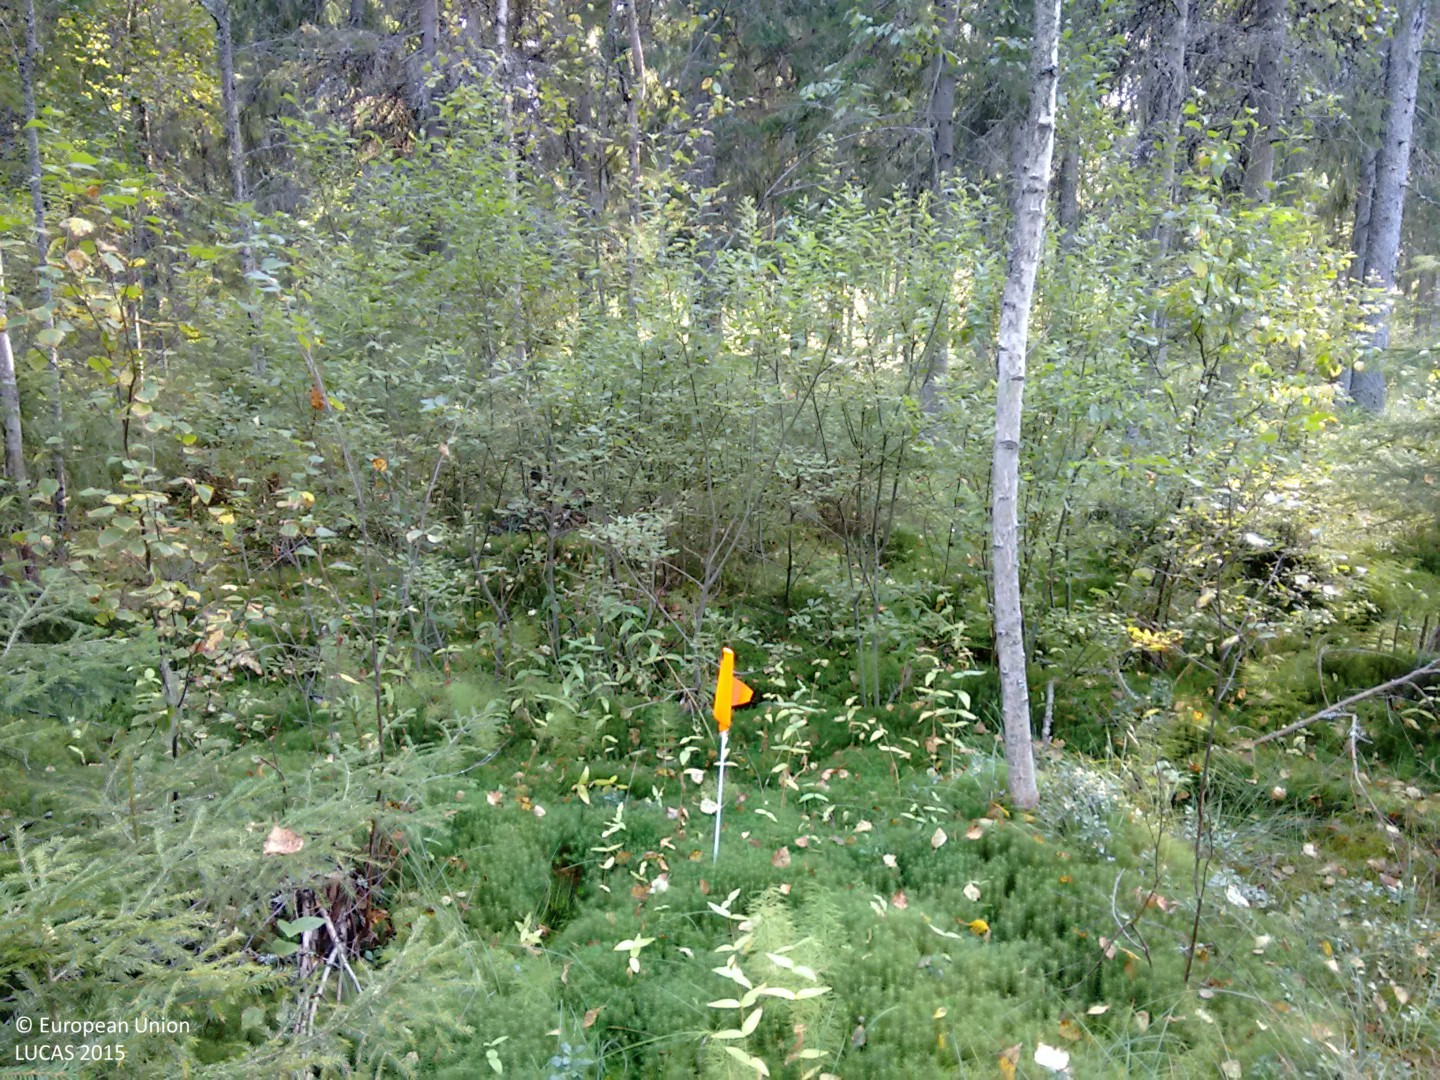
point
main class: Woodland
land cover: Spruce dominated mixed woodland
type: hemiboreal forest and nemoral coniferous forest and mixed broadleaved-coniferous forest
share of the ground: > 75 %
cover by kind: coniferous forest trees 55 %, broadleaved forest trees 30 %, shrubs 5 %, herbaceous plants 5 %, lichens and mosses 5 %
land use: Forestry
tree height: > 5 m
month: September
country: FI
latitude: 60.9760
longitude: 21.8276
